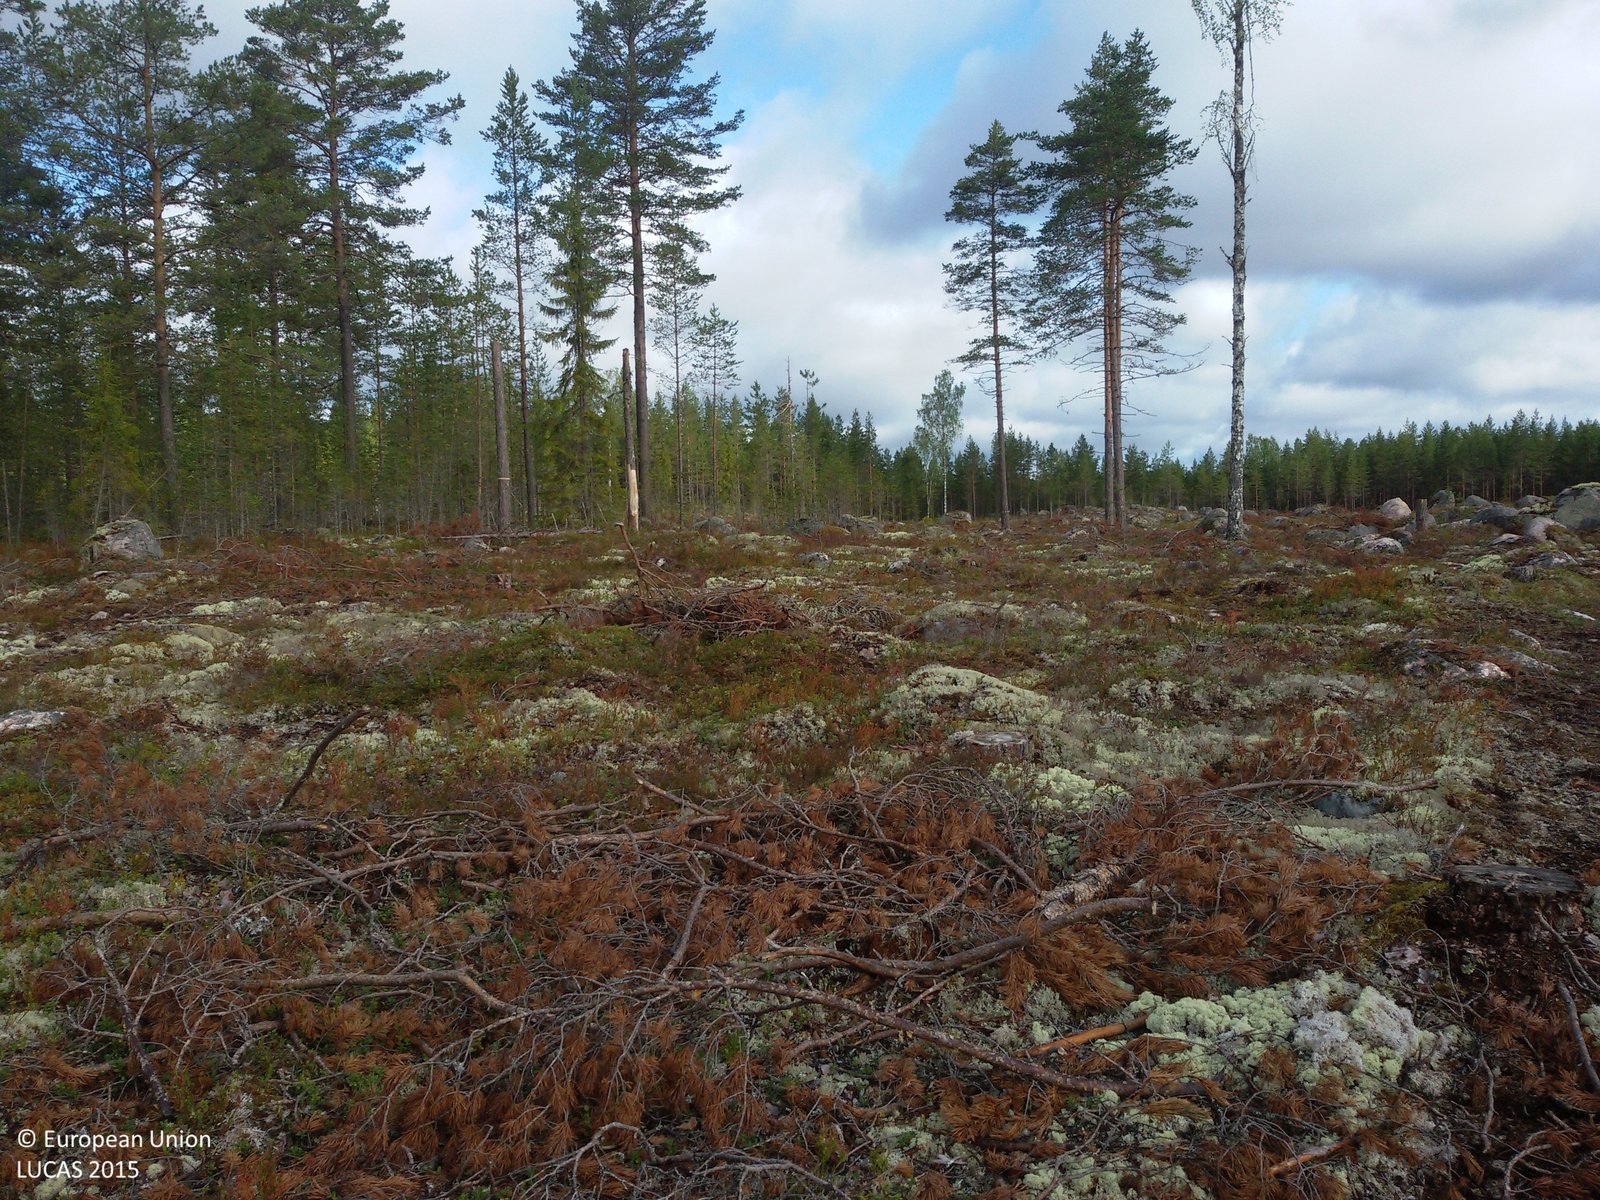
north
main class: Shrubland
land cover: Shrubland with sparse tree cover
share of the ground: 25 - 50 %
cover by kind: shrubs 35 %, lichens and mosses 25 %, unconsolidated bare surface 25 %, herbaceous plants 10 %, coniferous forest trees 5 %
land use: Forestry
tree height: < 5 m
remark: Clear cut
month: September
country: SE
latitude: 61.0351
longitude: 15.3726
